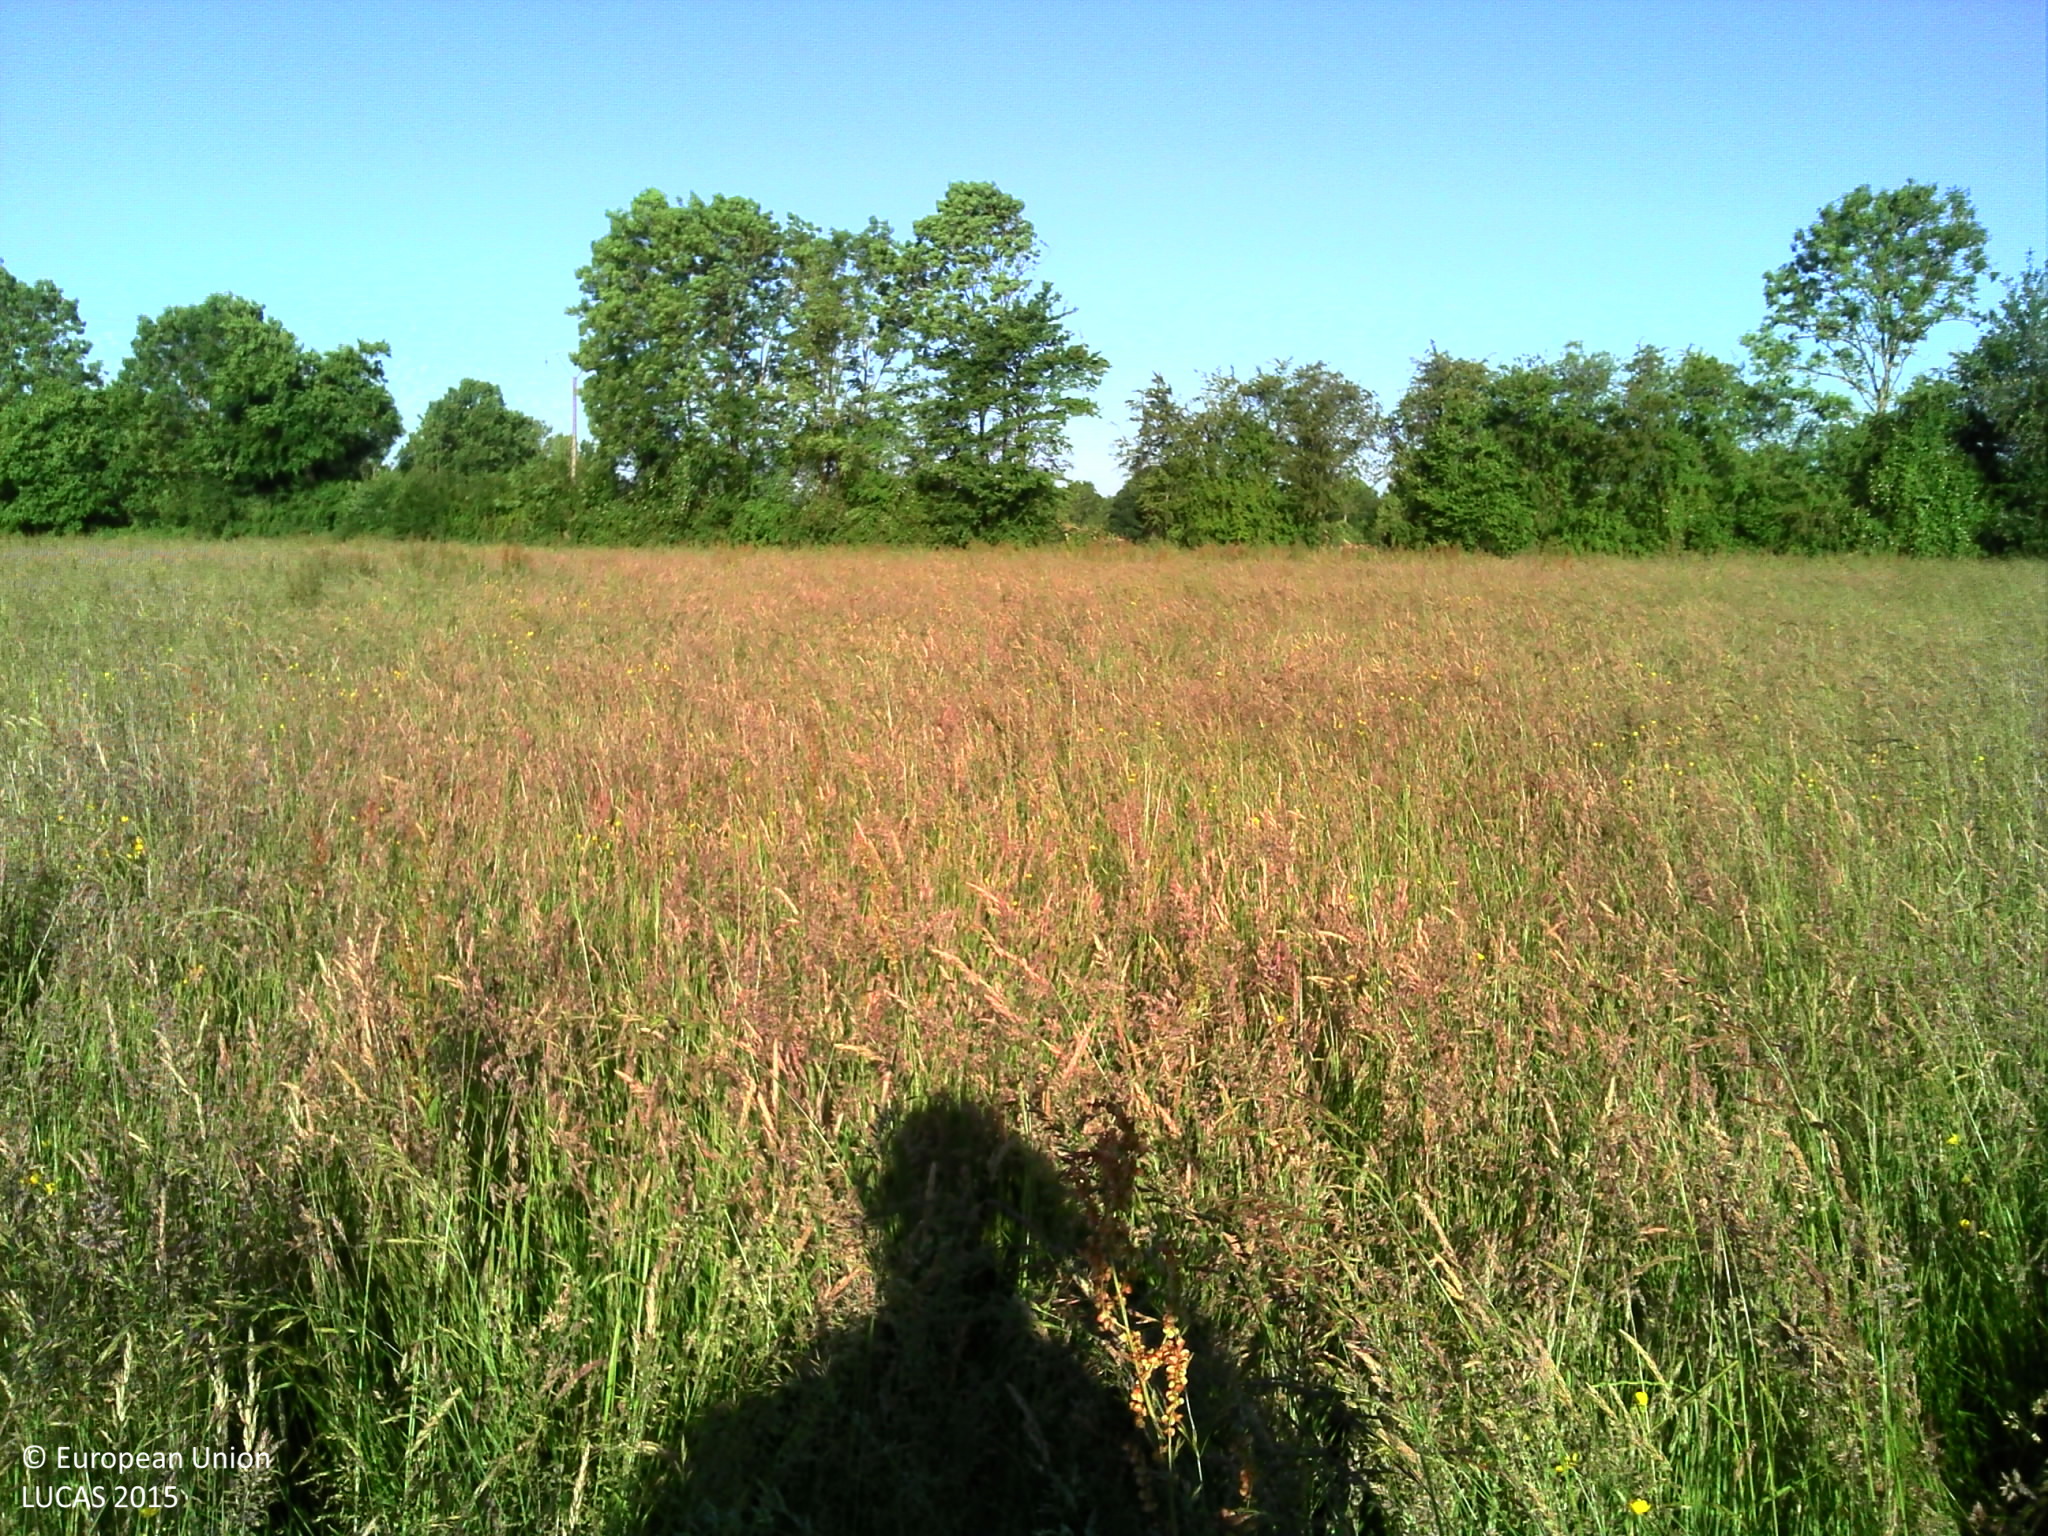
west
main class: Grassland
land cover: Grassland without tree/shrub cover
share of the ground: > 75 %
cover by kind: herbaceous plants 100 %
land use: Agriculture (excluding fallow land and kitchen gardens)
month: June
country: FR
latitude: 49.1768
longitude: 0.3564
